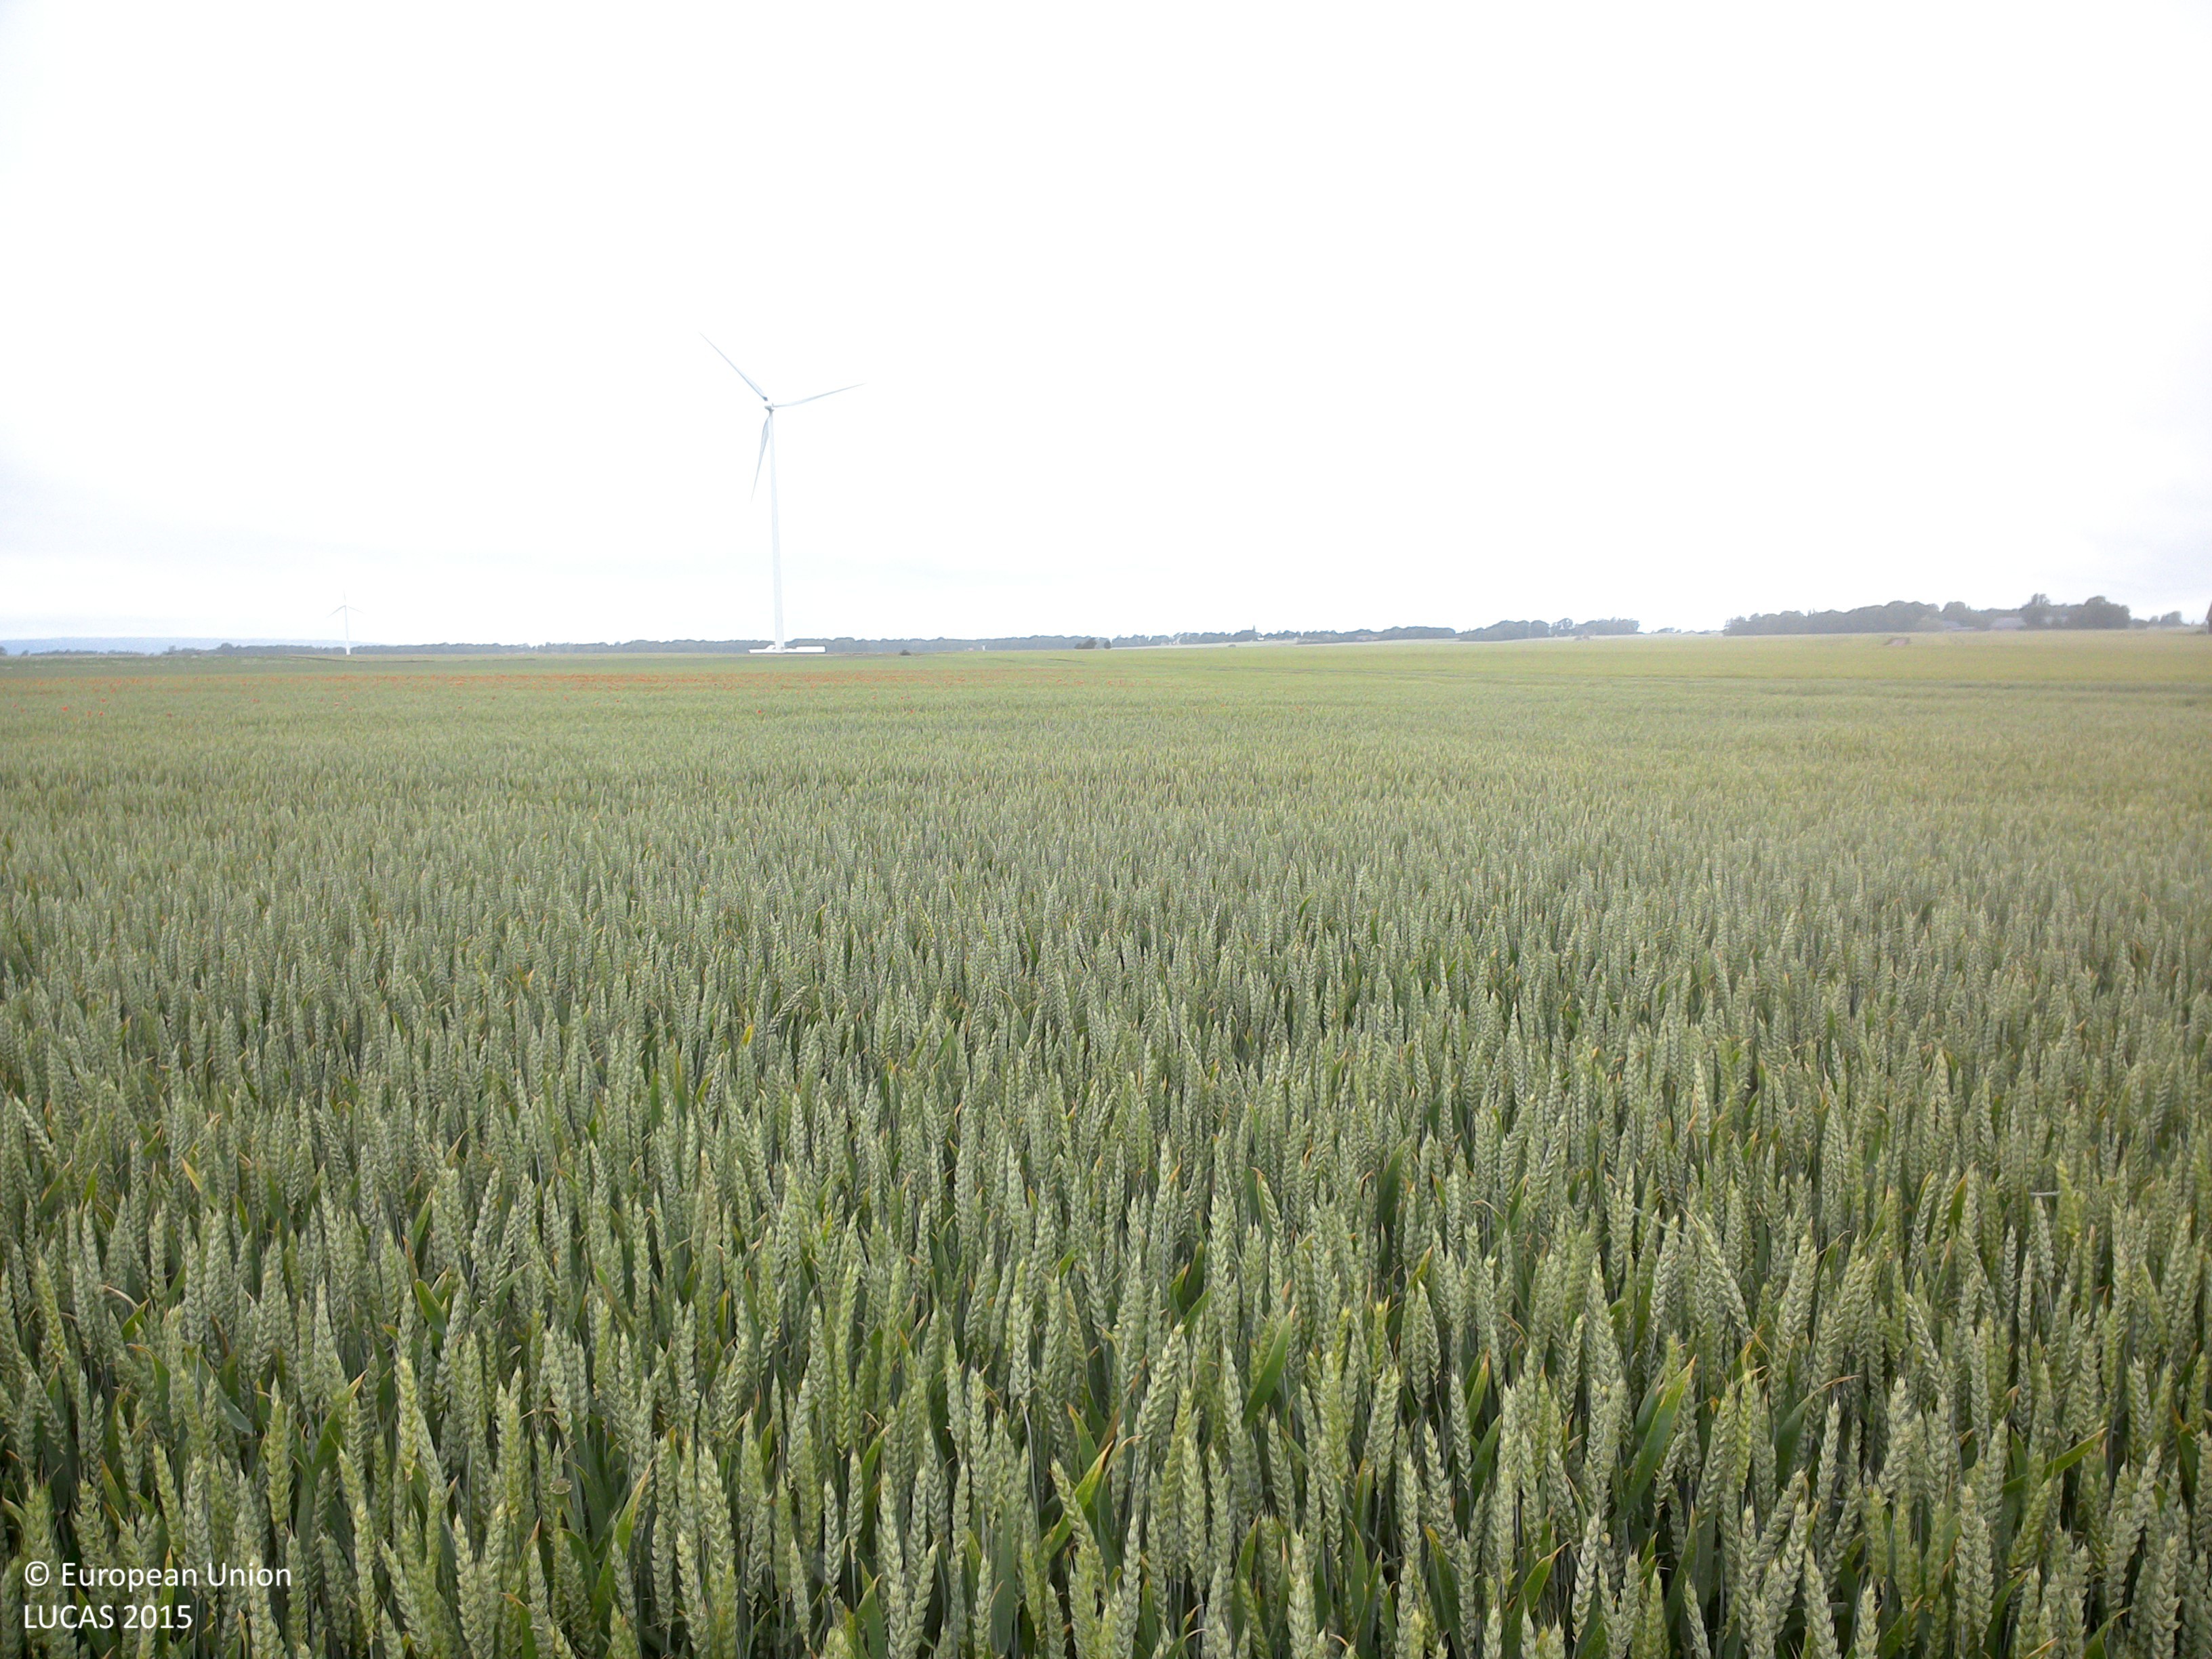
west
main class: Cropland
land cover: Common wheat
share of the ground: > 75 %
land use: Agriculture (excluding fallow land and kitchen gardens)
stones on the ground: < 10 %
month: July
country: SE
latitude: 58.3621
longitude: 14.9679
